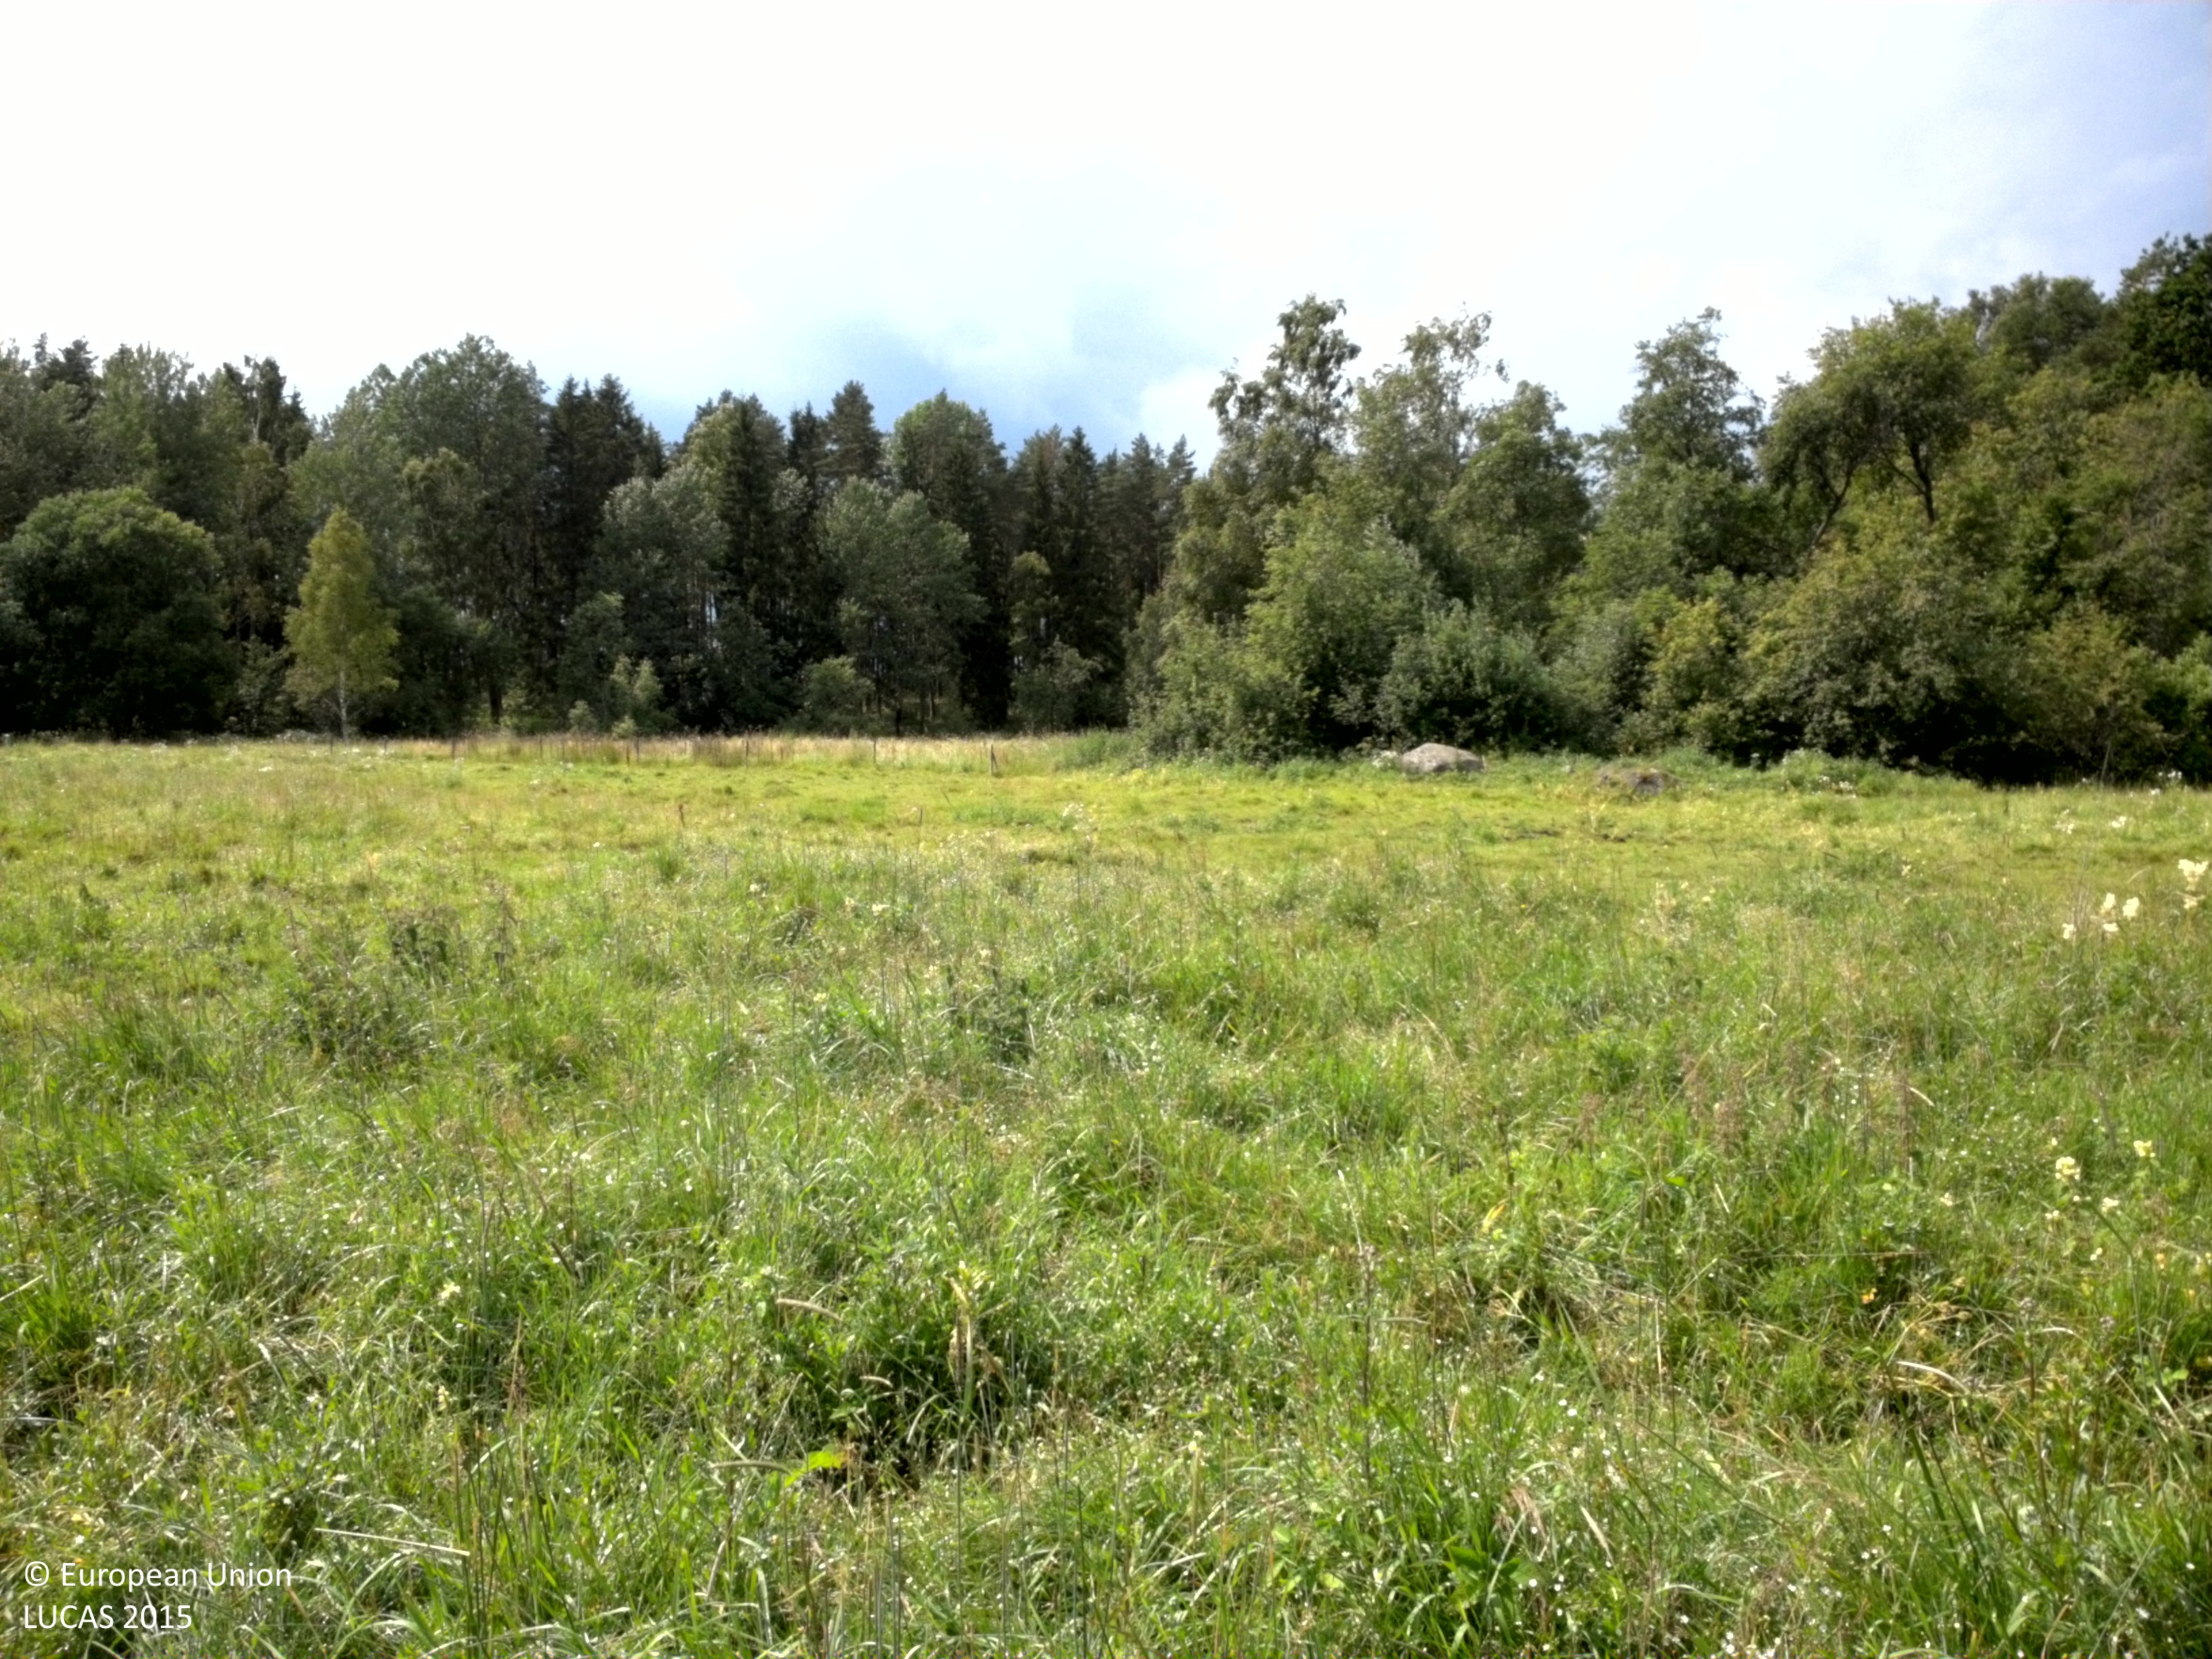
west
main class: Grassland
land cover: Grassland without tree/shrub cover
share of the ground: > 75 %
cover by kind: herbaceous plants 100 %
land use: Agriculture (excluding fallow land and kitchen gardens)
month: July
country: SE
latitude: 59.9534
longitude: 18.6108
